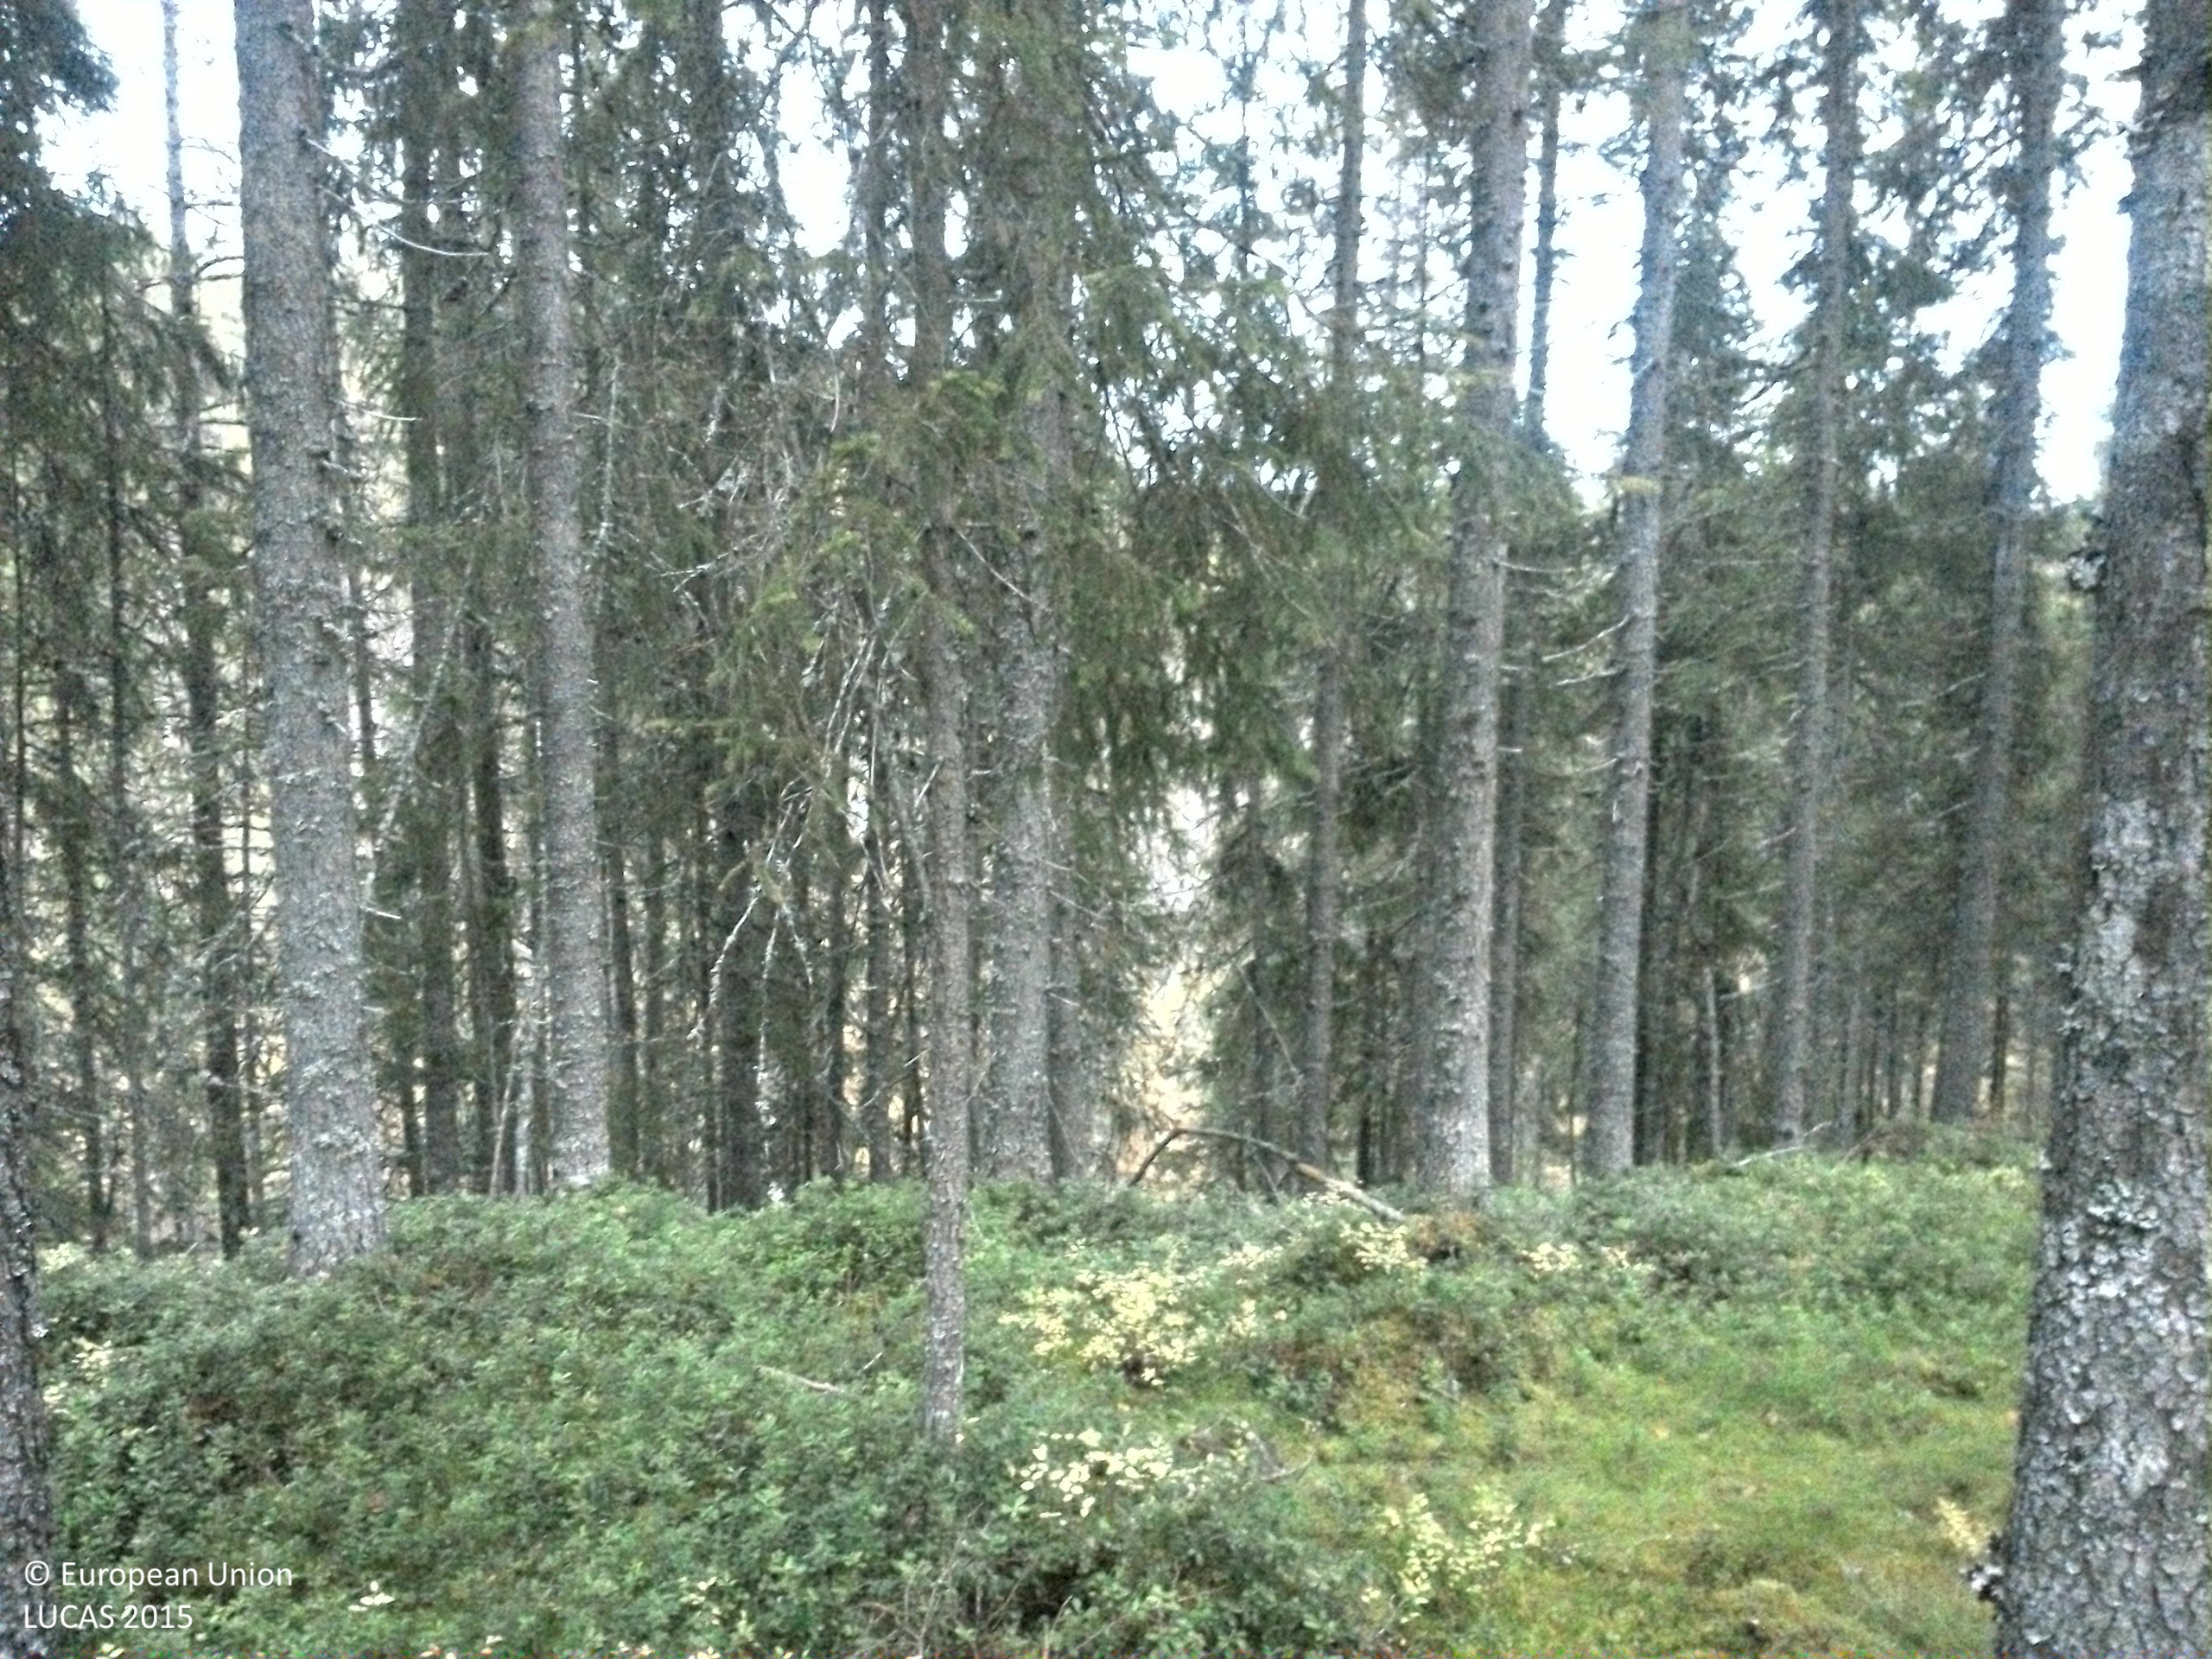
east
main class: Woodland
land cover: Spruce dominated coniferous woodland
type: boreal forest
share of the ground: 50 - 75 %
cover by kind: coniferous forest trees 50 %, shrubs 30 %, lichens and mosses 20 %
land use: Forestry
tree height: > 5 m
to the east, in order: Spruce dominated coniferous woodland; Spruce dominated mixed woodland; Rivers and streams; Spruce dominated mixed woodland
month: October
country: SE
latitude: 64.2915
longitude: 15.8175
